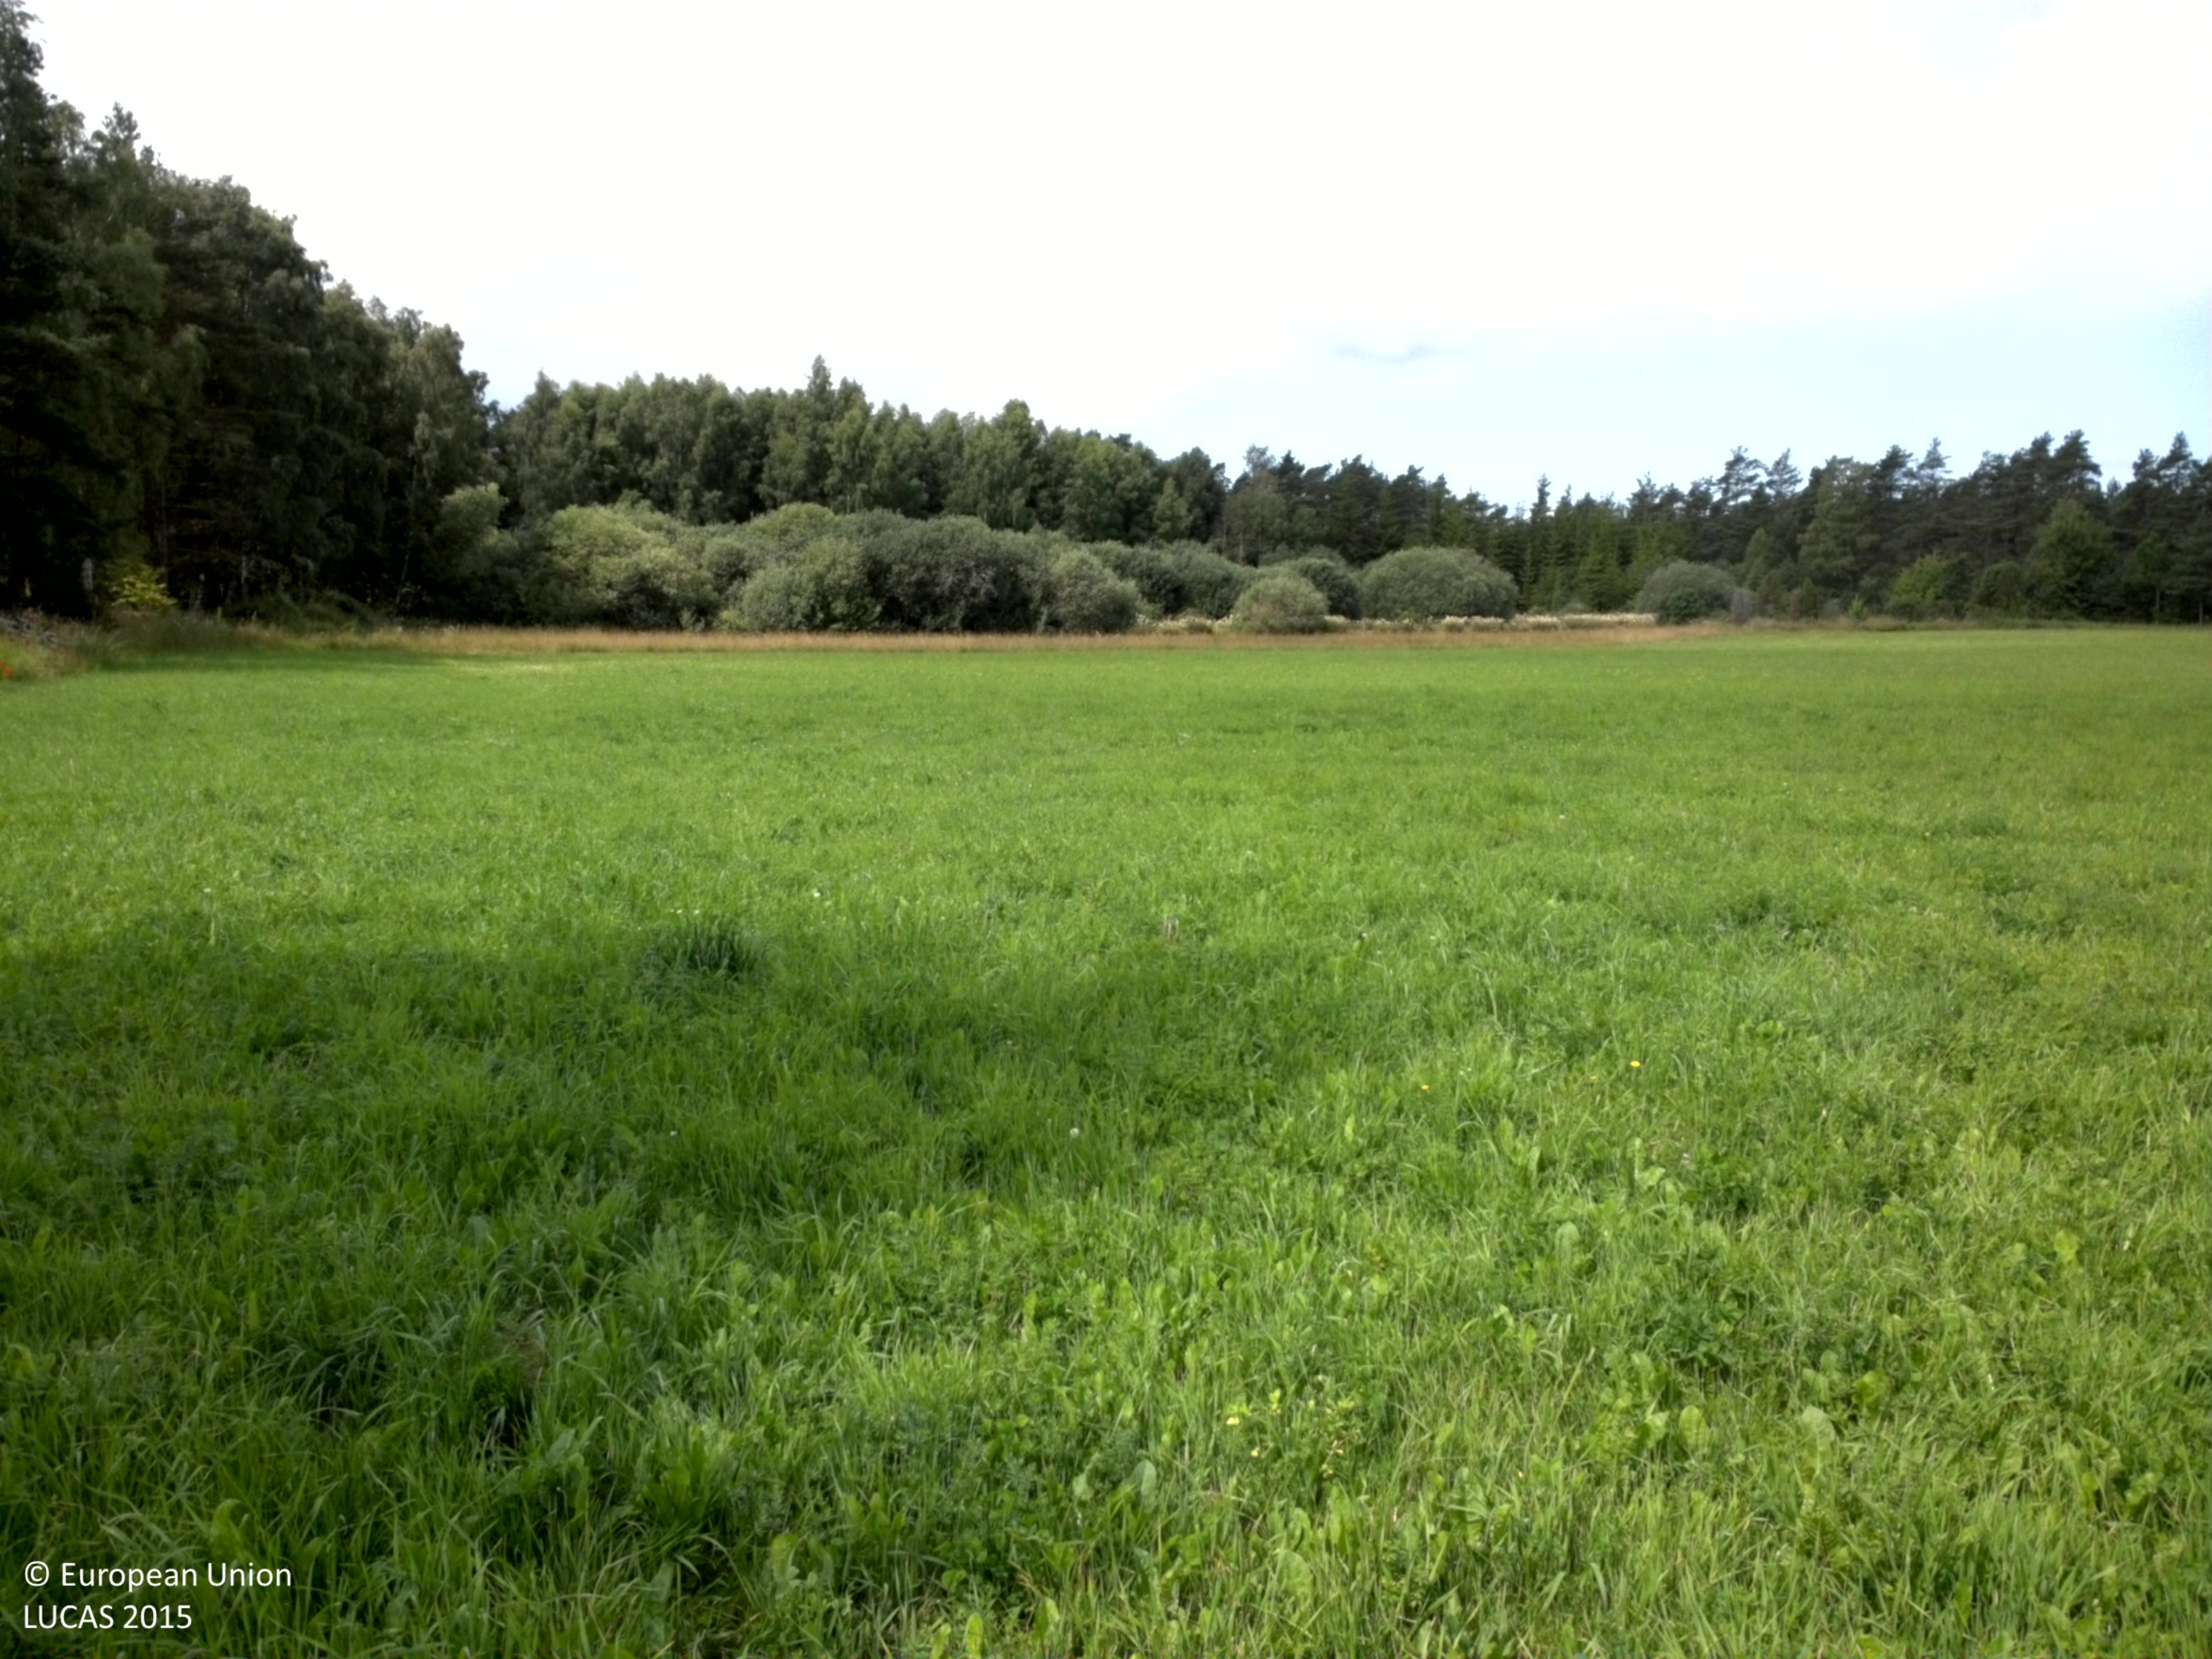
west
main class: Grassland
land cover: Grassland without tree/shrub cover
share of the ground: > 75 %
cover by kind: herbaceous plants 100 %
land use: Agriculture (excluding fallow land and kitchen gardens)
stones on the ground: < 10 %
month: July
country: SE
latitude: 57.5688
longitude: 18.5183
